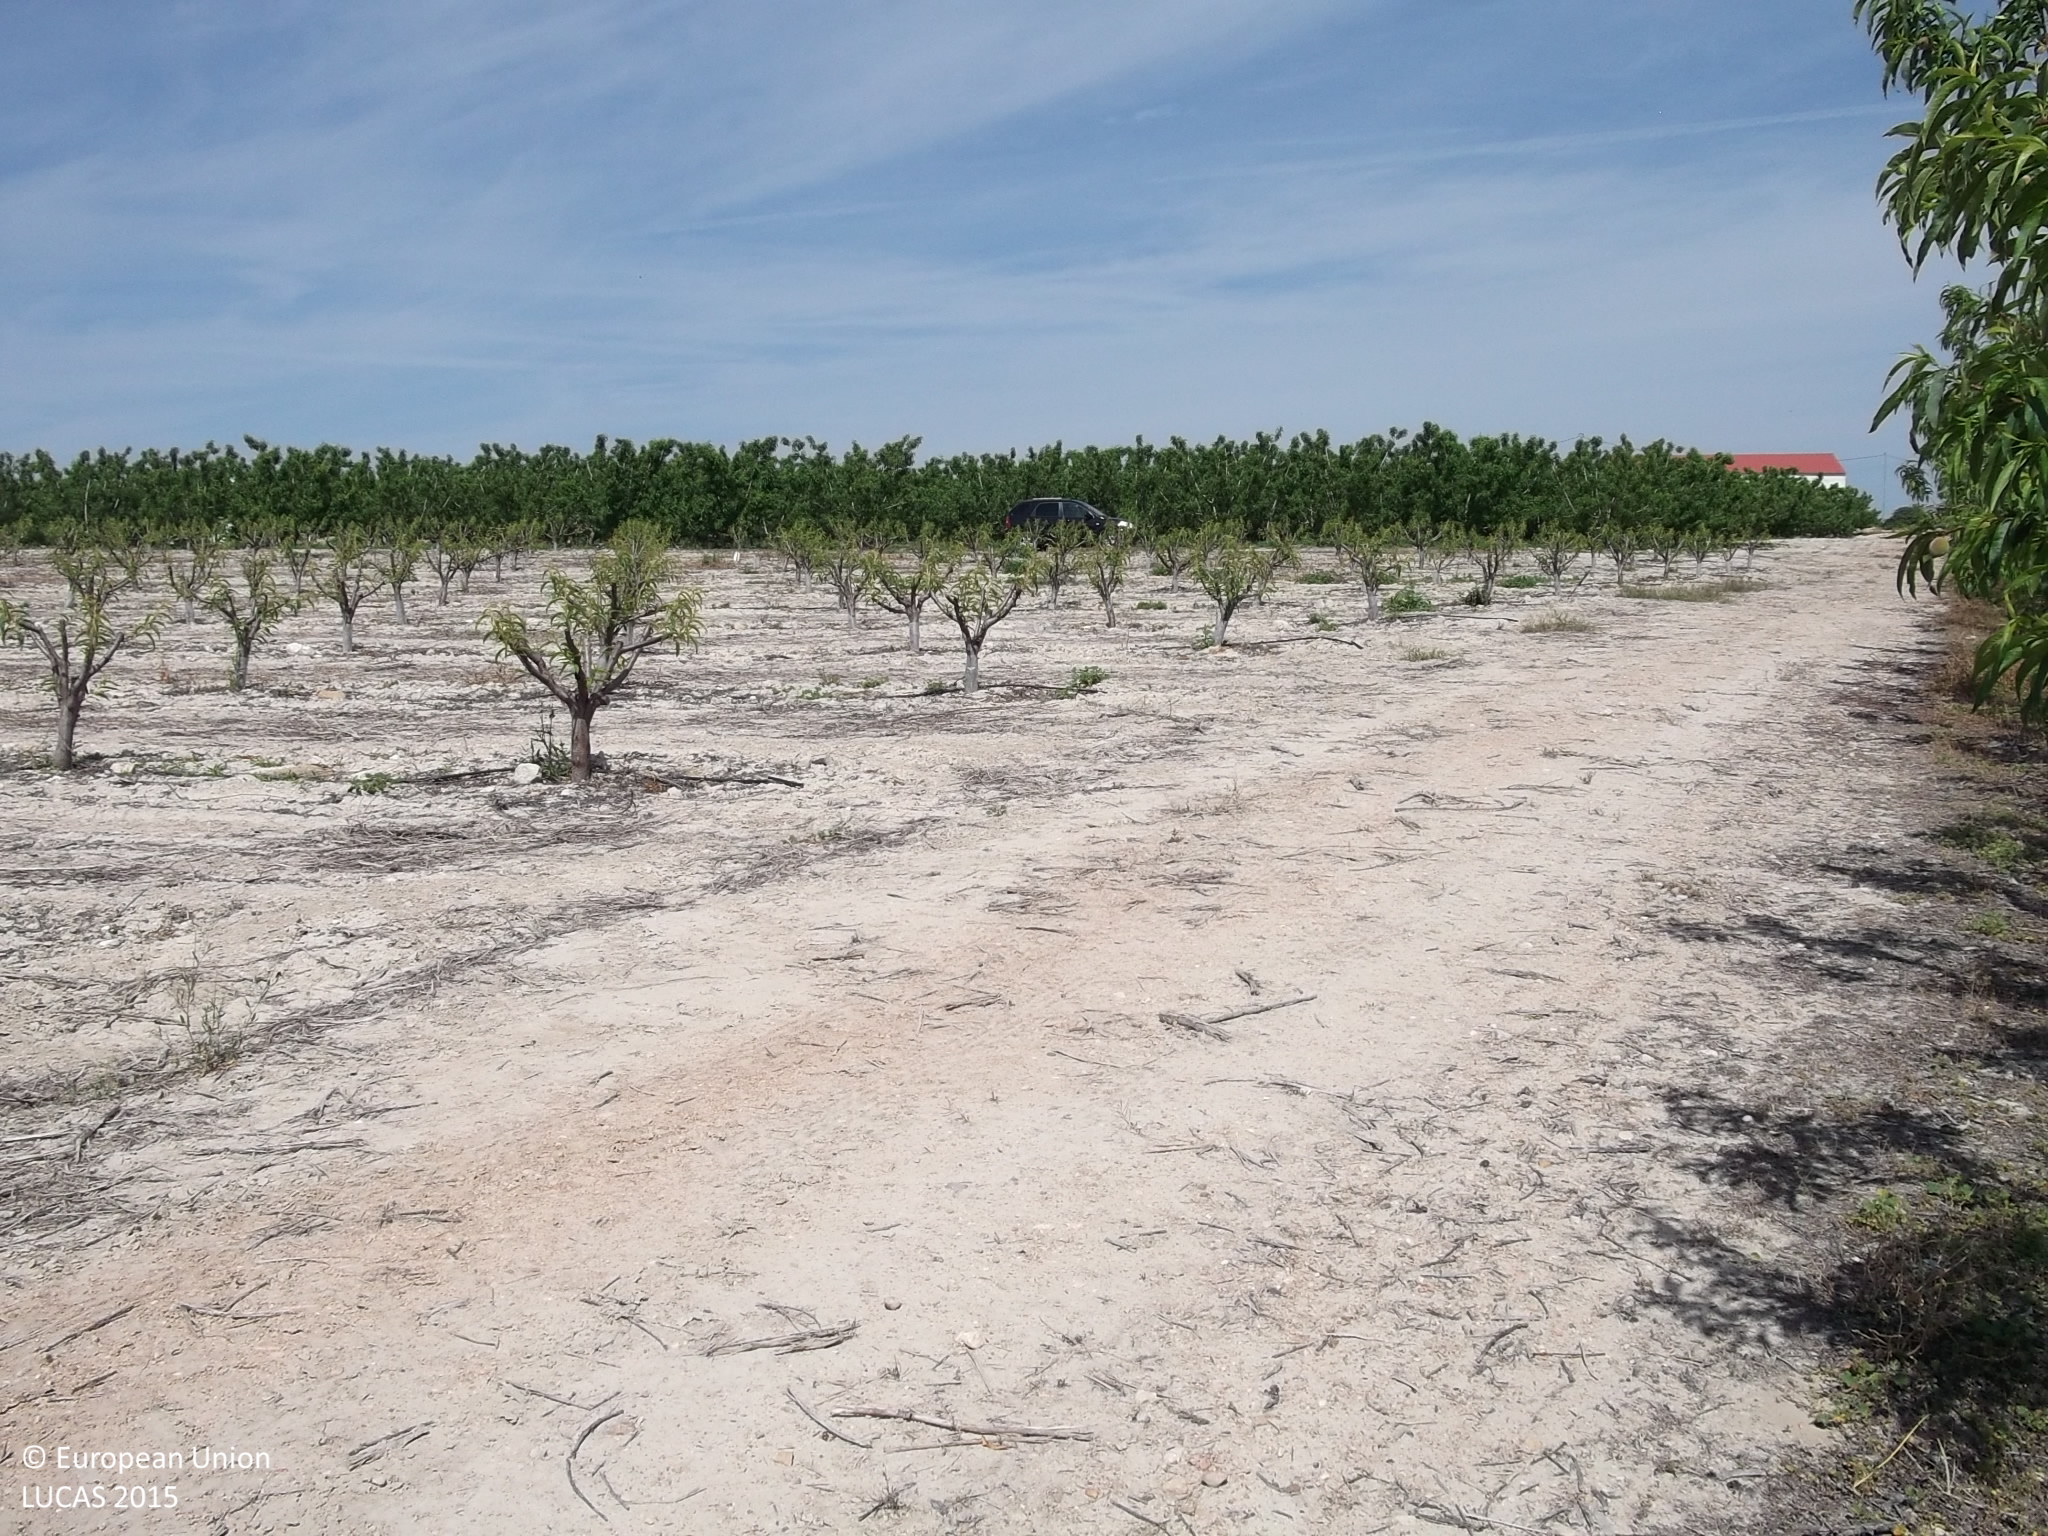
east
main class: Cropland
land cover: Other fruit trees and berries
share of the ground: 25 - 50 %
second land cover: Spontaneously vegetated surfaces
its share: 25 - 50 %
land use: Agriculture (excluding fallow land and kitchen gardens)
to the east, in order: Other fruit trees and berries; Spontaneously vegetated surfaces; Tracks; Shrubland with sparse tree cover; Ditches and canals; Shrubland with sparse tree cover; Tracks; Permanent crops (only in case pi); Tracks; Shrubland without tree cover; Tracks
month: April
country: ES
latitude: 38.2759
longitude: -1.4773
